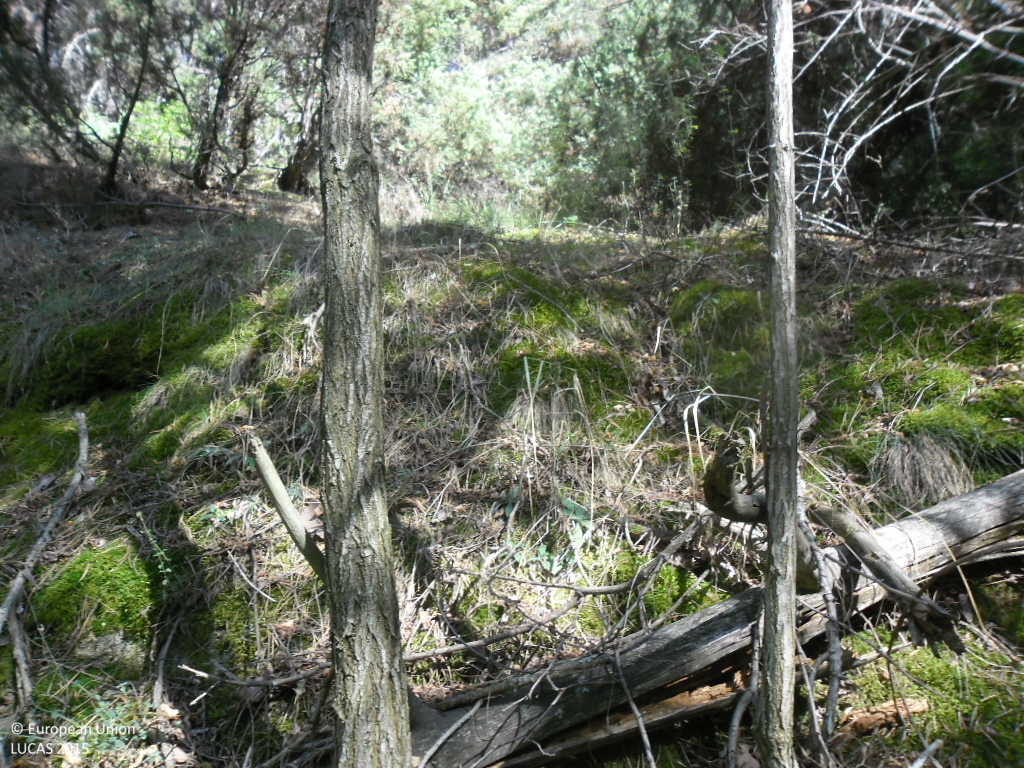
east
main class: Woodland
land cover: Pine dominated coniferous woodland
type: hemiboreal forest and nemoral coniferous forest and mixed broadleaved-coniferous forest
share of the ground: > 75 %
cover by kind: coniferous forest trees 100 %
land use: Forestry
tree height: < 5 m
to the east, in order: Pine dominated coniferous woodland; Tracks; Rivers and streams; Pine dominated coniferous woodland; Tracks; Pine dominated coniferous woodland
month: September
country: BG
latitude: 41.8007
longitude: 23.2264
